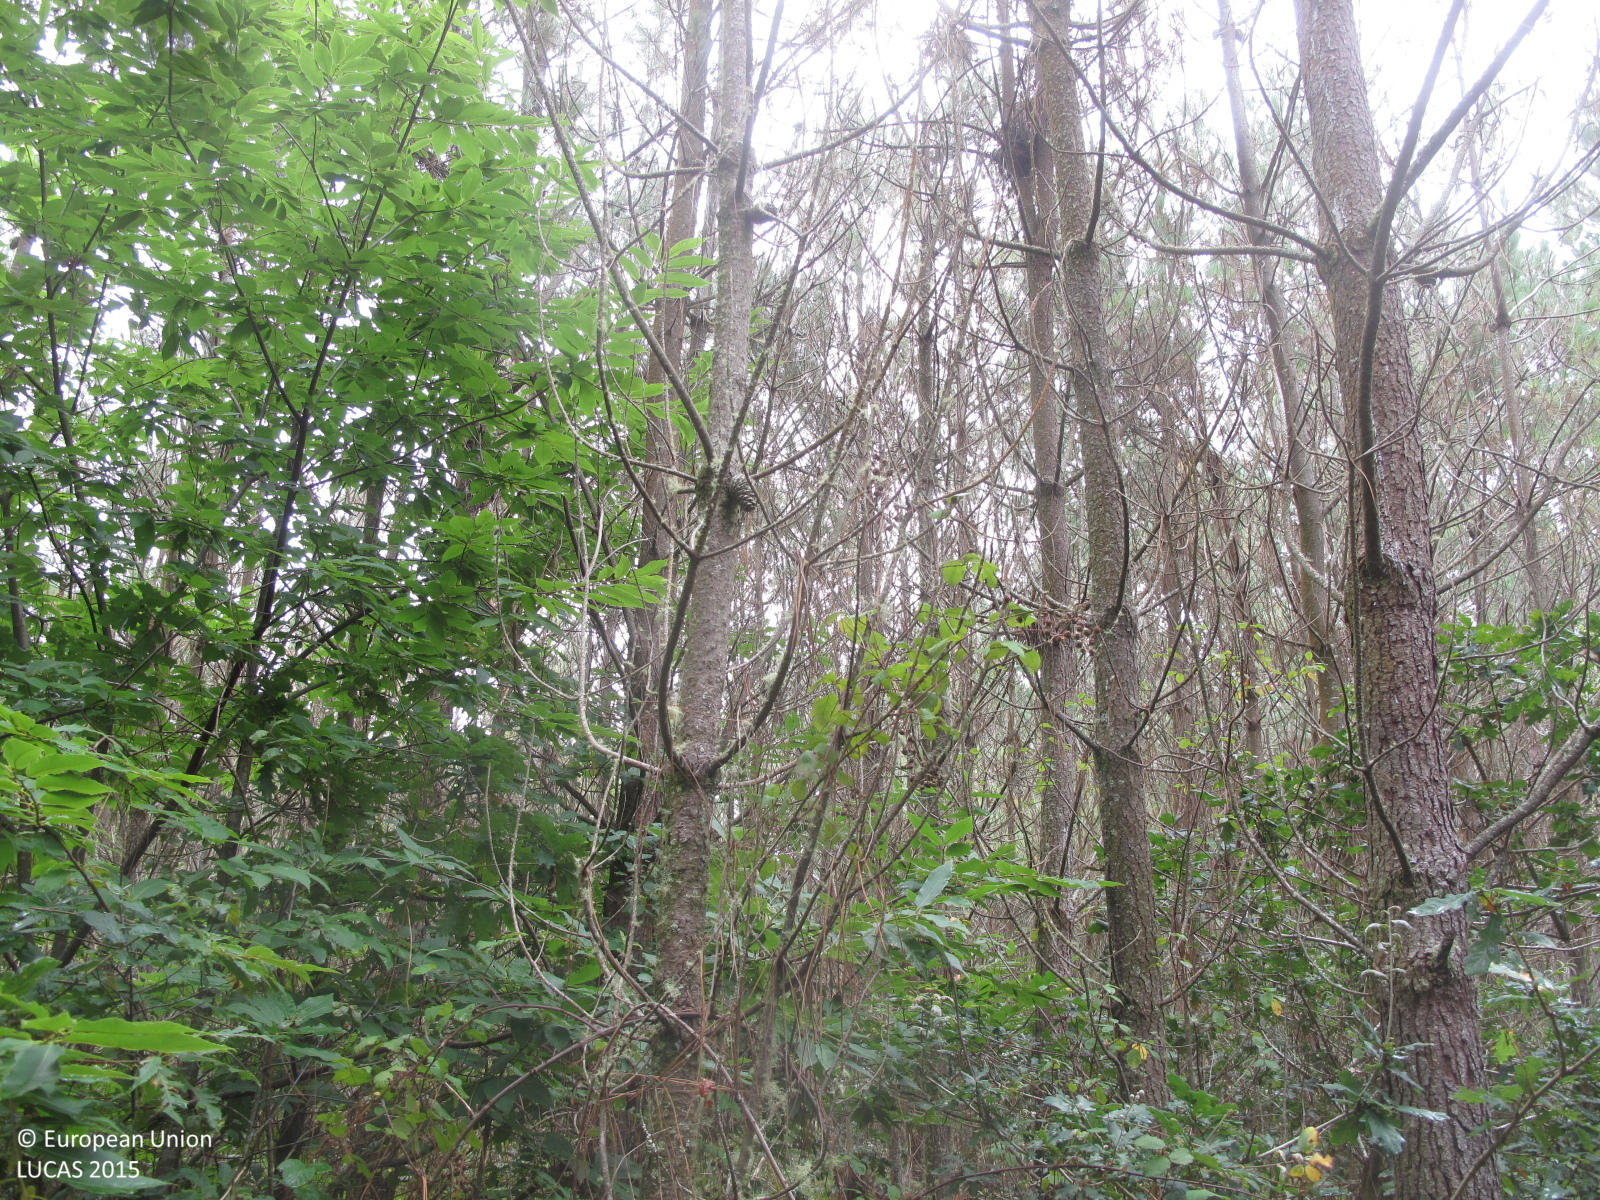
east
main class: Woodland
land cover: Pine dominated mixed woodland
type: hemiboreal forest and nemoral coniferous forest and mixed broadleaved-coniferous forest
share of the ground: 50 - 75 %
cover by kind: coniferous forest trees 40 %, shrubs 30 %, broadleaved forest trees 20 %, herbaceous plants 10 %
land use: Forestry
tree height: > 5 m
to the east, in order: Pine dominated mixed woodland; Tracks; Pine dominated mixed woodland; Other mixed woodland; Pine dominated coniferous woodland
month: July
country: ES
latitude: 42.9941
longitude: -9.2262
